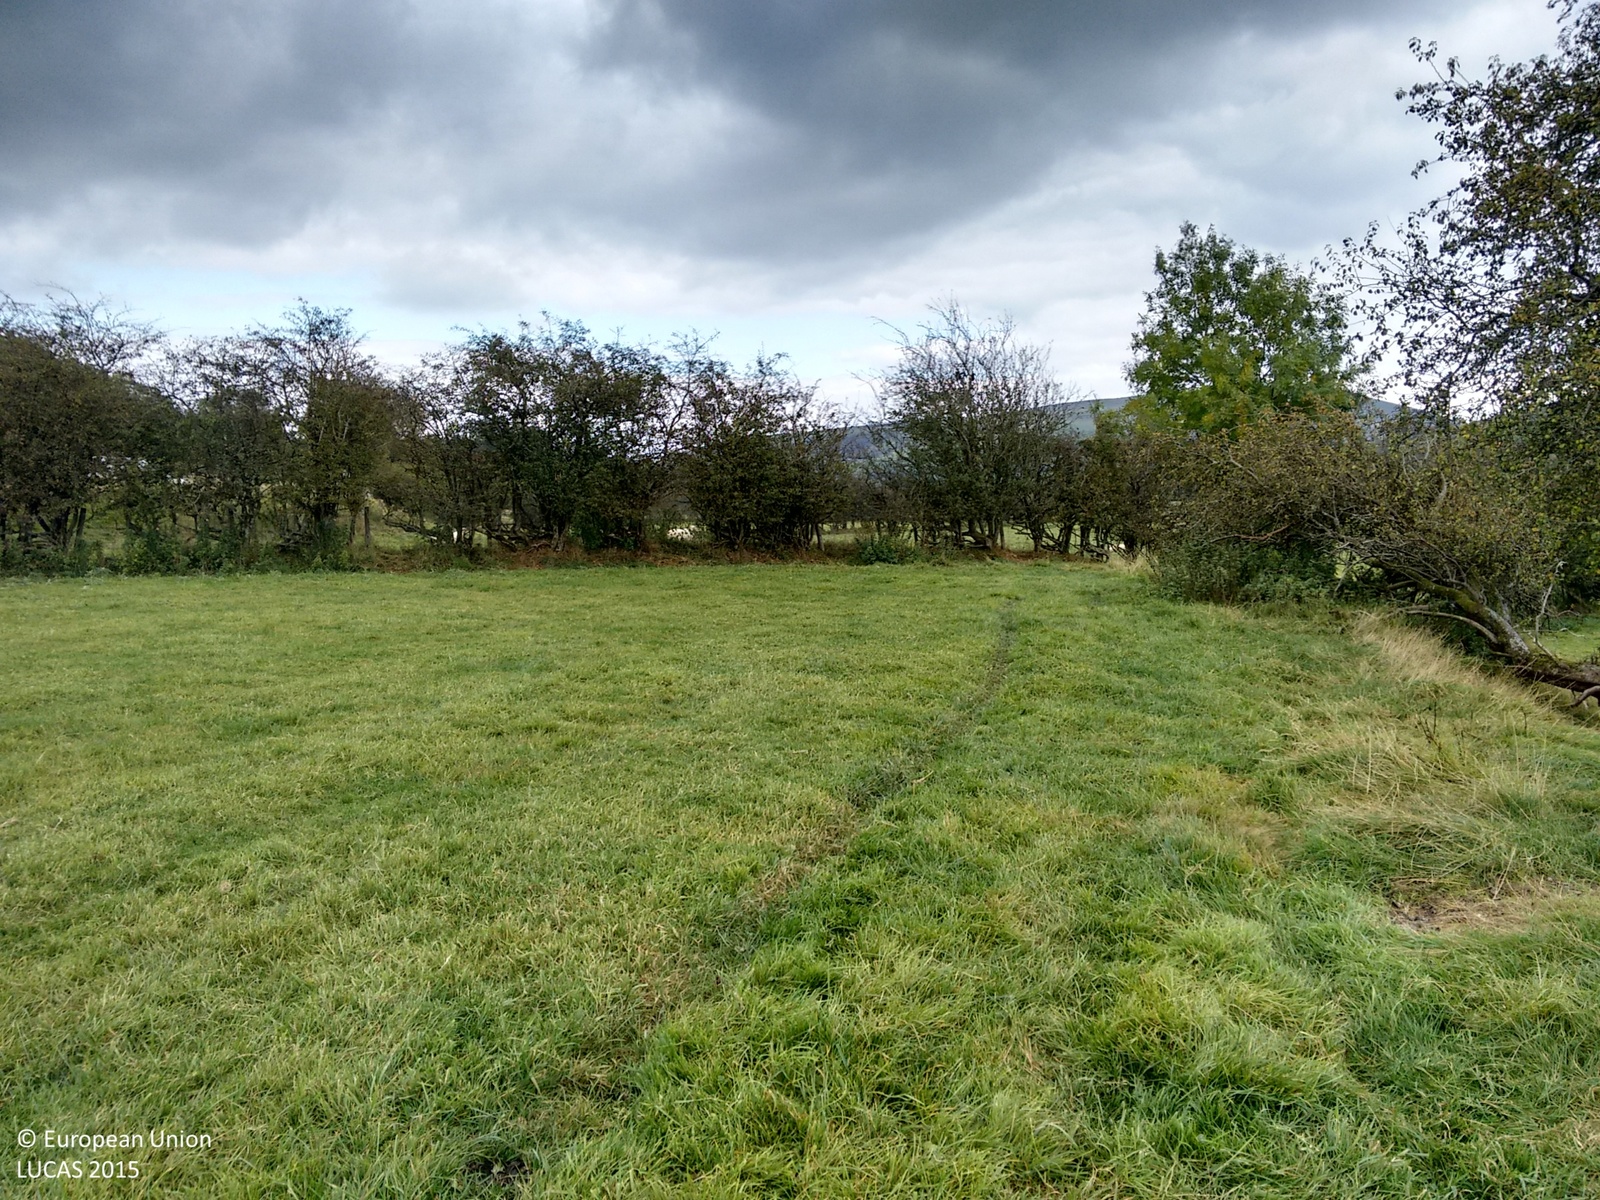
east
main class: Grassland
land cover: Grassland without tree/shrub cover
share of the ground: > 75 %
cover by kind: herbaceous plants 100 %
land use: Agriculture (excluding fallow land and kitchen gardens)
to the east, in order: Grassland without tree/shrub cover; Fences; Abandoned hedges; Grassland without tree/shrub cover; Abandoned hedges; Grassland without tree/shrub cover; Fences; Grassland without tree/shrub cover
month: October
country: GB
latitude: 52.4080
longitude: -3.6256
